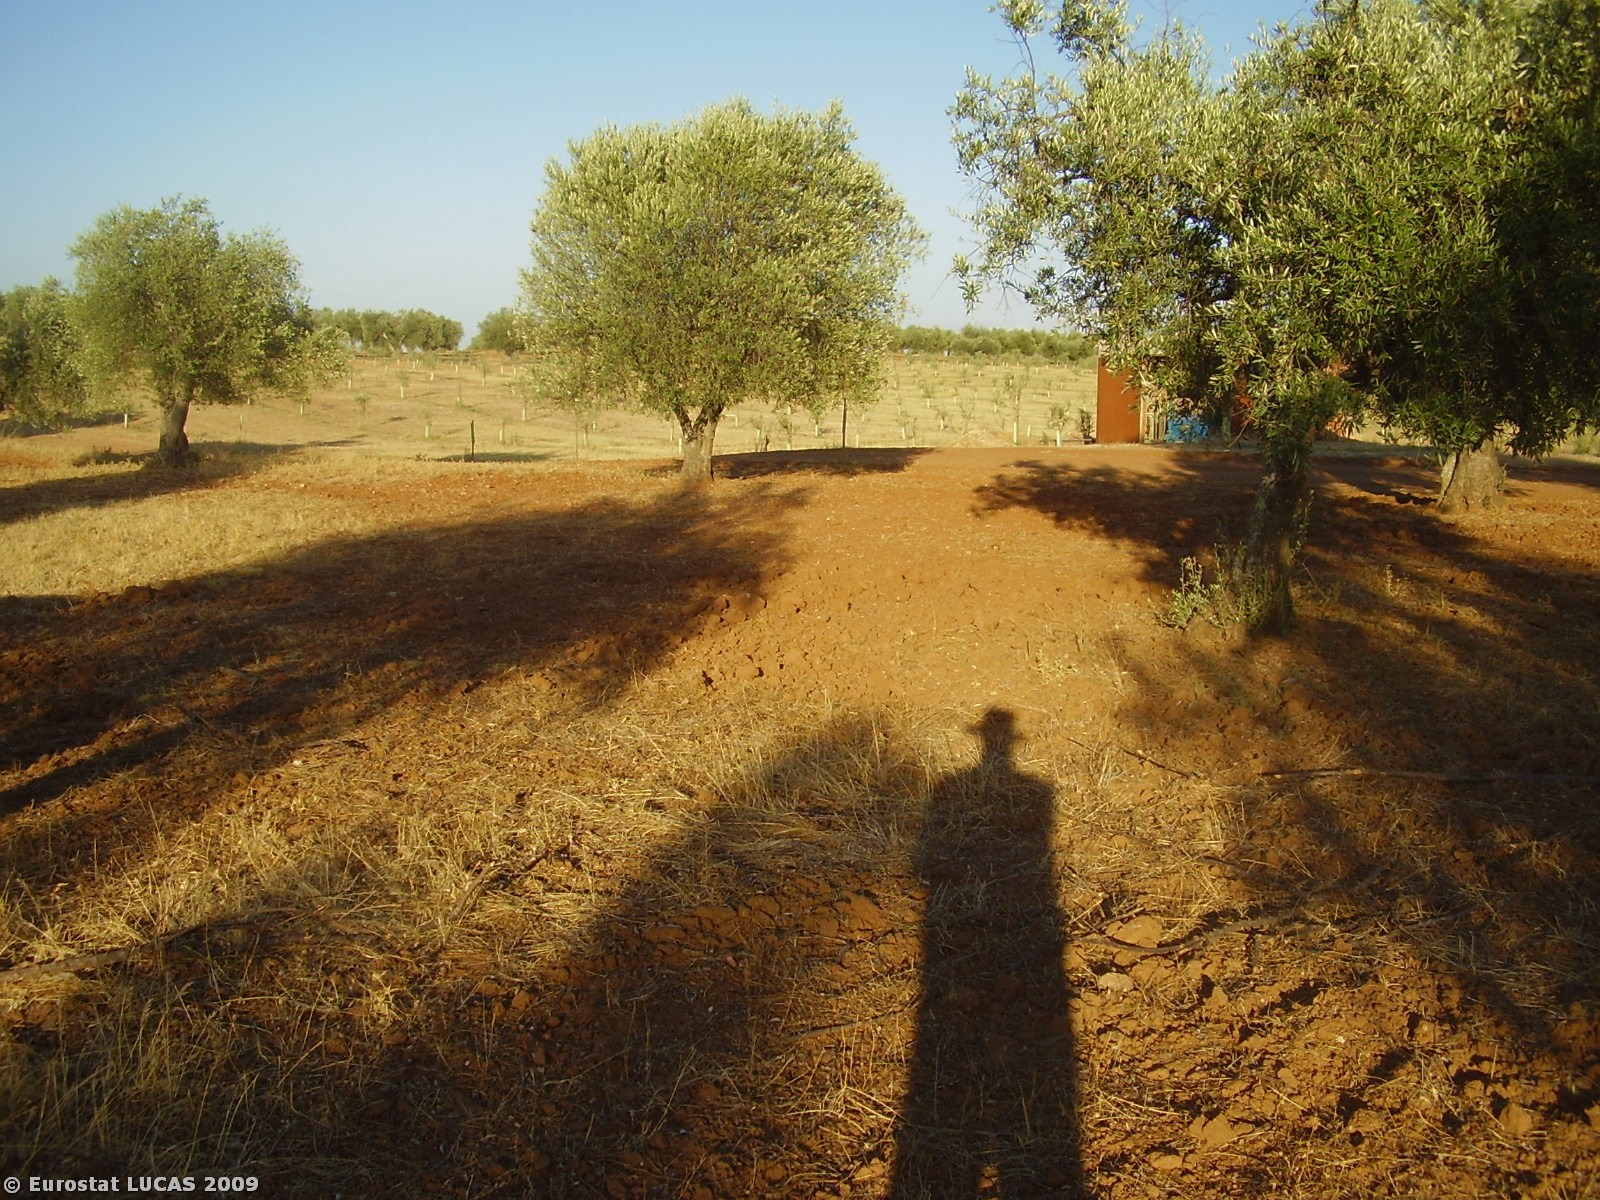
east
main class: Cropland
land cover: Olive groves
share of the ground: 10 - 25 %
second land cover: Spontaneously vegetated surfaces
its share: 10 - 25 %
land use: Agriculture (excluding fallow land and kitchen gardens)
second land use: Fallow land
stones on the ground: 25 - 50 %
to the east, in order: Olive groves; Spontaneously vegetated surfaces; Olive groves; Tracks; Olive groves; Tracks
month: August
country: PT
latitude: 38.0419
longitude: -7.5573
